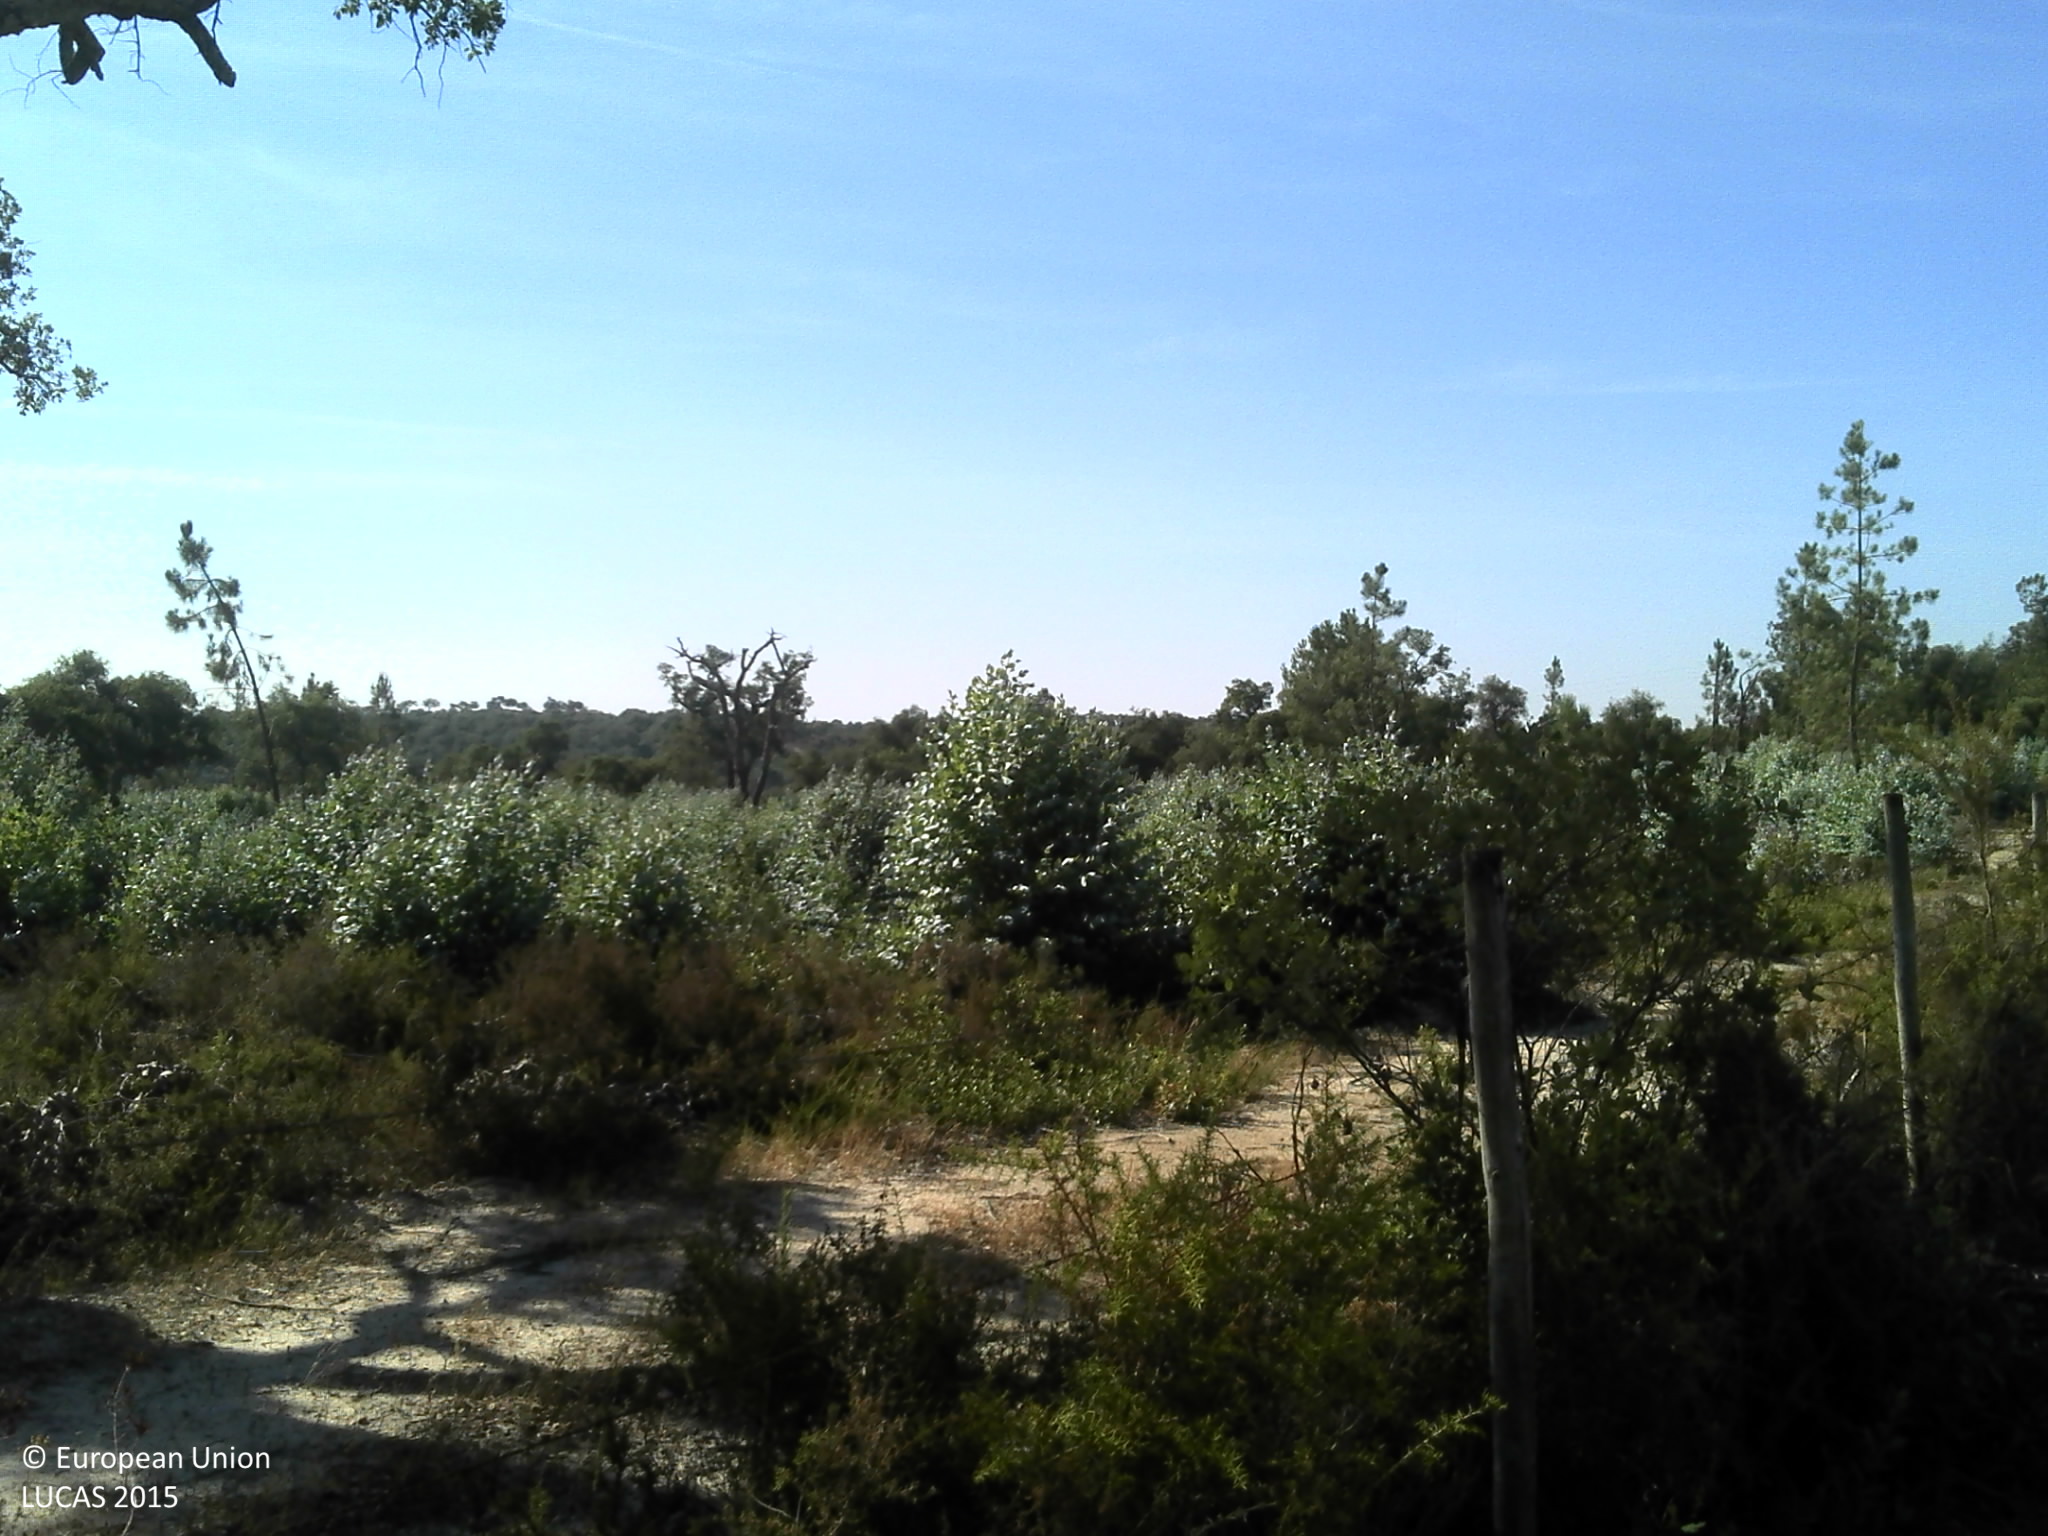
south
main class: Woodland
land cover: Broadleaved woodland
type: exotic forest
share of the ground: 25 - 50 %
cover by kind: unconsolidated bare surface 65 %, broadleaved forest trees 25 %, herbaceous plants 10 %
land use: Forestry
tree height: < 5 m
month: July
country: PT
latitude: 39.2090
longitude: -8.3252
